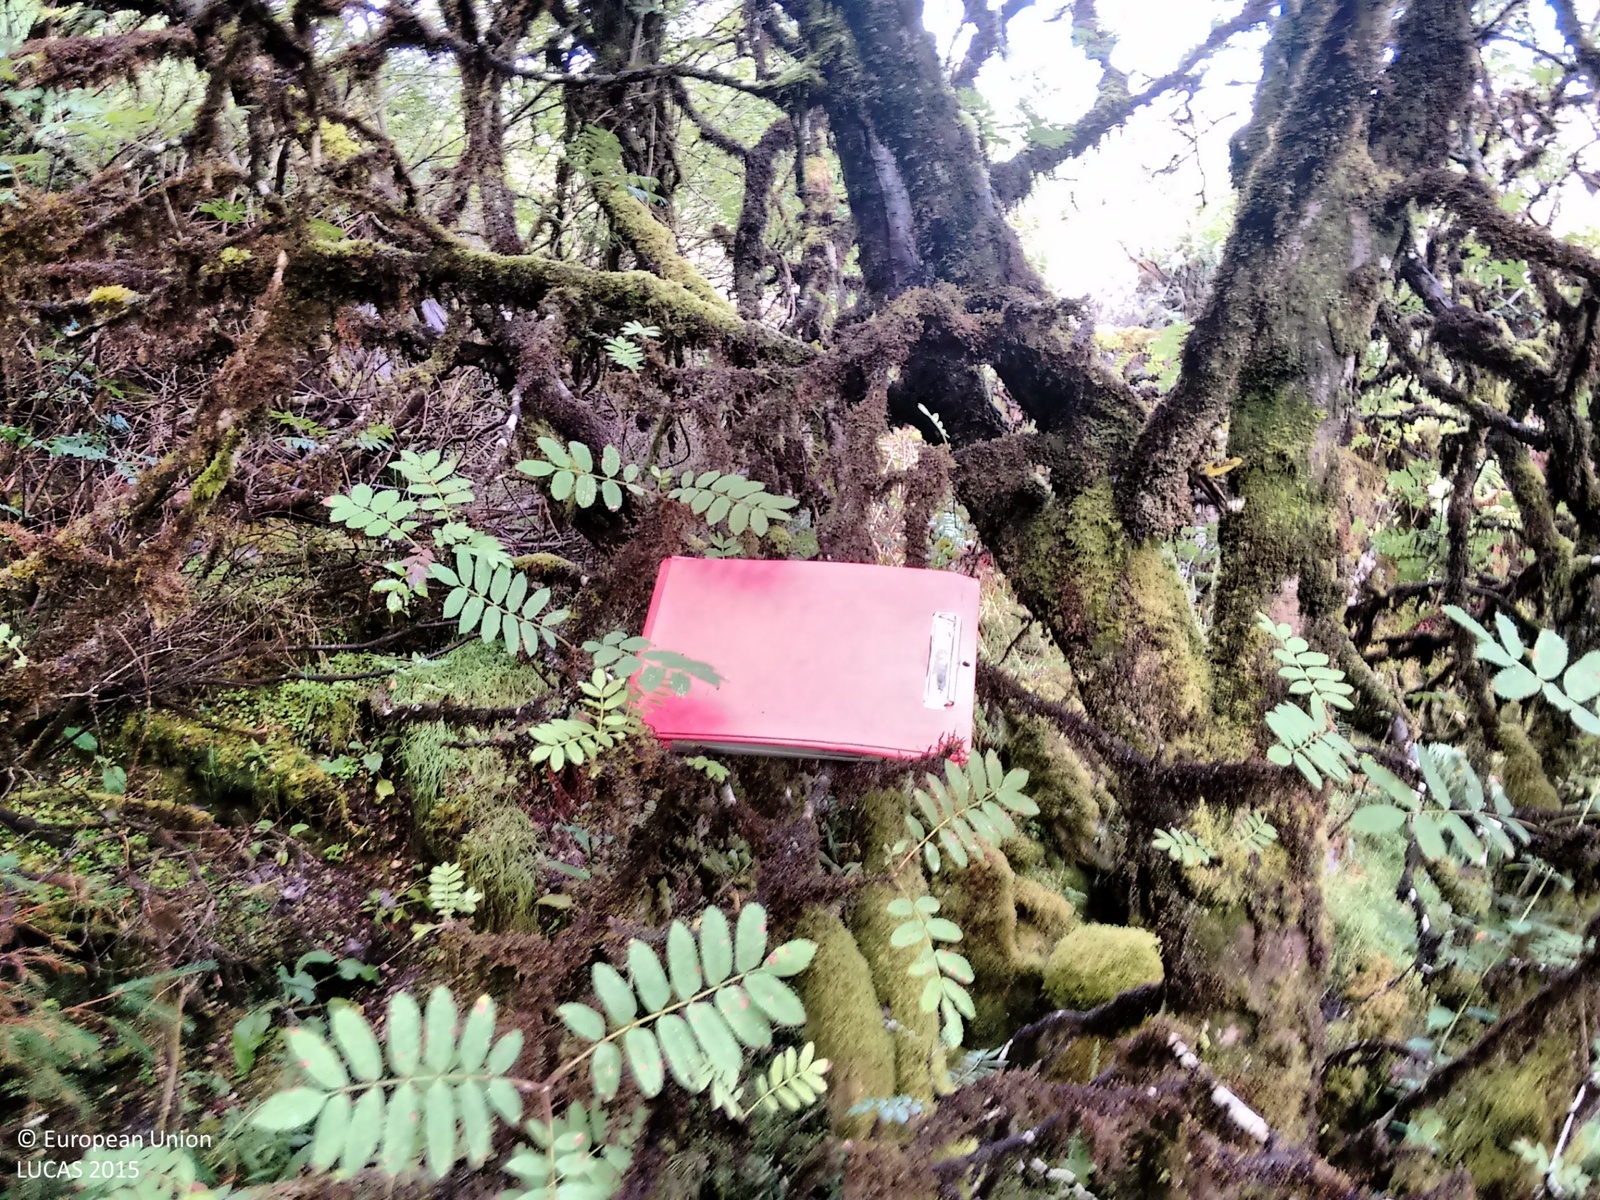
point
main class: Woodland
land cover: Other mixed woodland
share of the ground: > 75 %
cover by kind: broadleaved forest trees 60 %, coniferous forest trees 25 %, herbaceous plants 10 %, shrubs 5 %
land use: Forestry
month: August
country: IE
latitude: 51.8255
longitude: -9.3048
